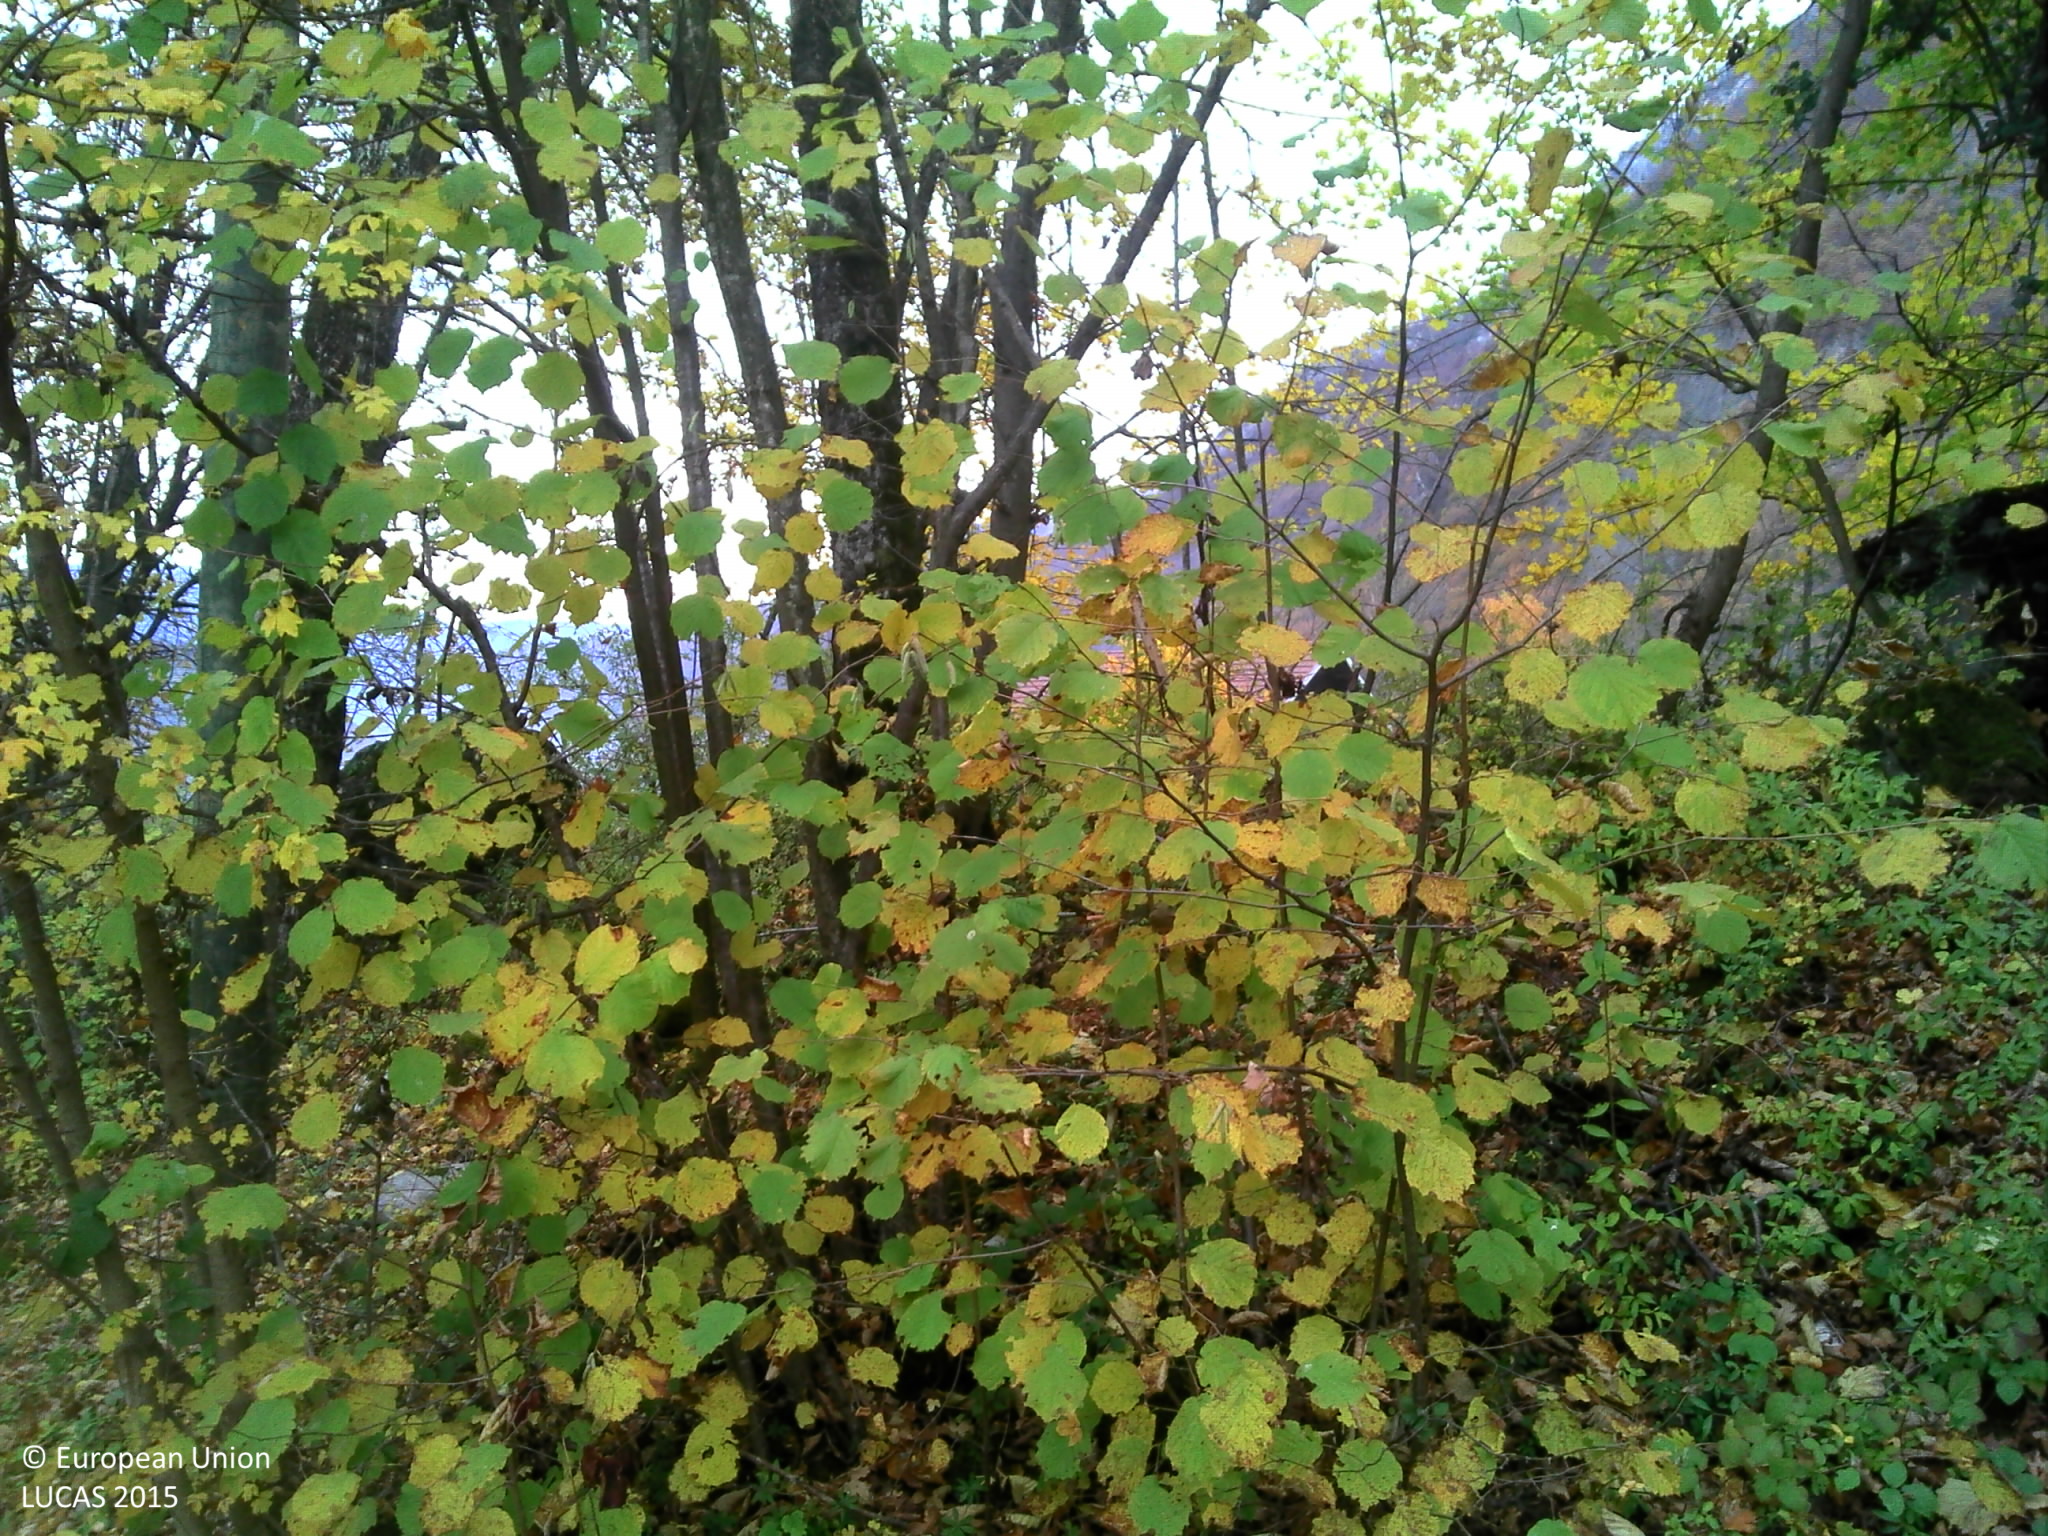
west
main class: Grassland
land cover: Grassland without tree/shrub cover
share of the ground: > 75 %
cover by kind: herbaceous plants 100 %
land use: Residential
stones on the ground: < 10 %
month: November
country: FR
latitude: 45.7674
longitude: 6.3909
